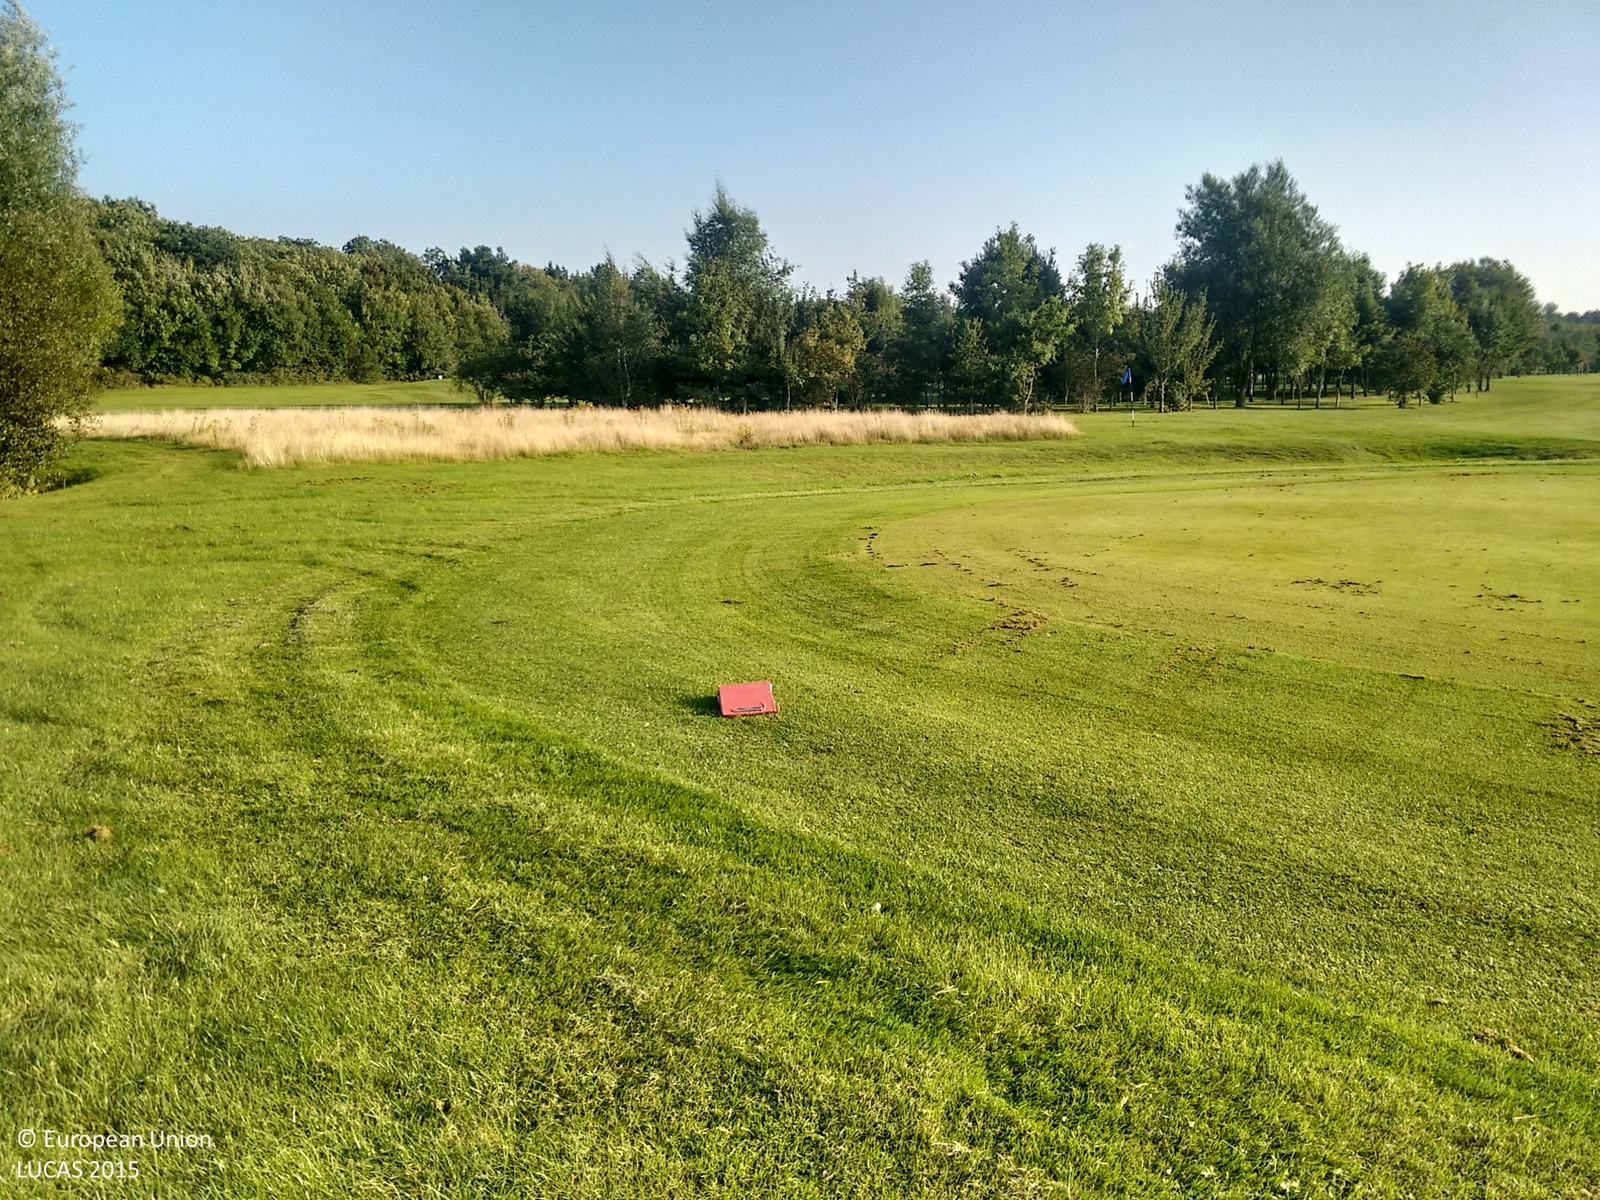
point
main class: Grassland
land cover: Grassland without tree/shrub cover
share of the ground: > 75 %
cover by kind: herbaceous plants 100 %
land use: Sport
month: September
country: GB
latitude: 52.2928
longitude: 1.5506
